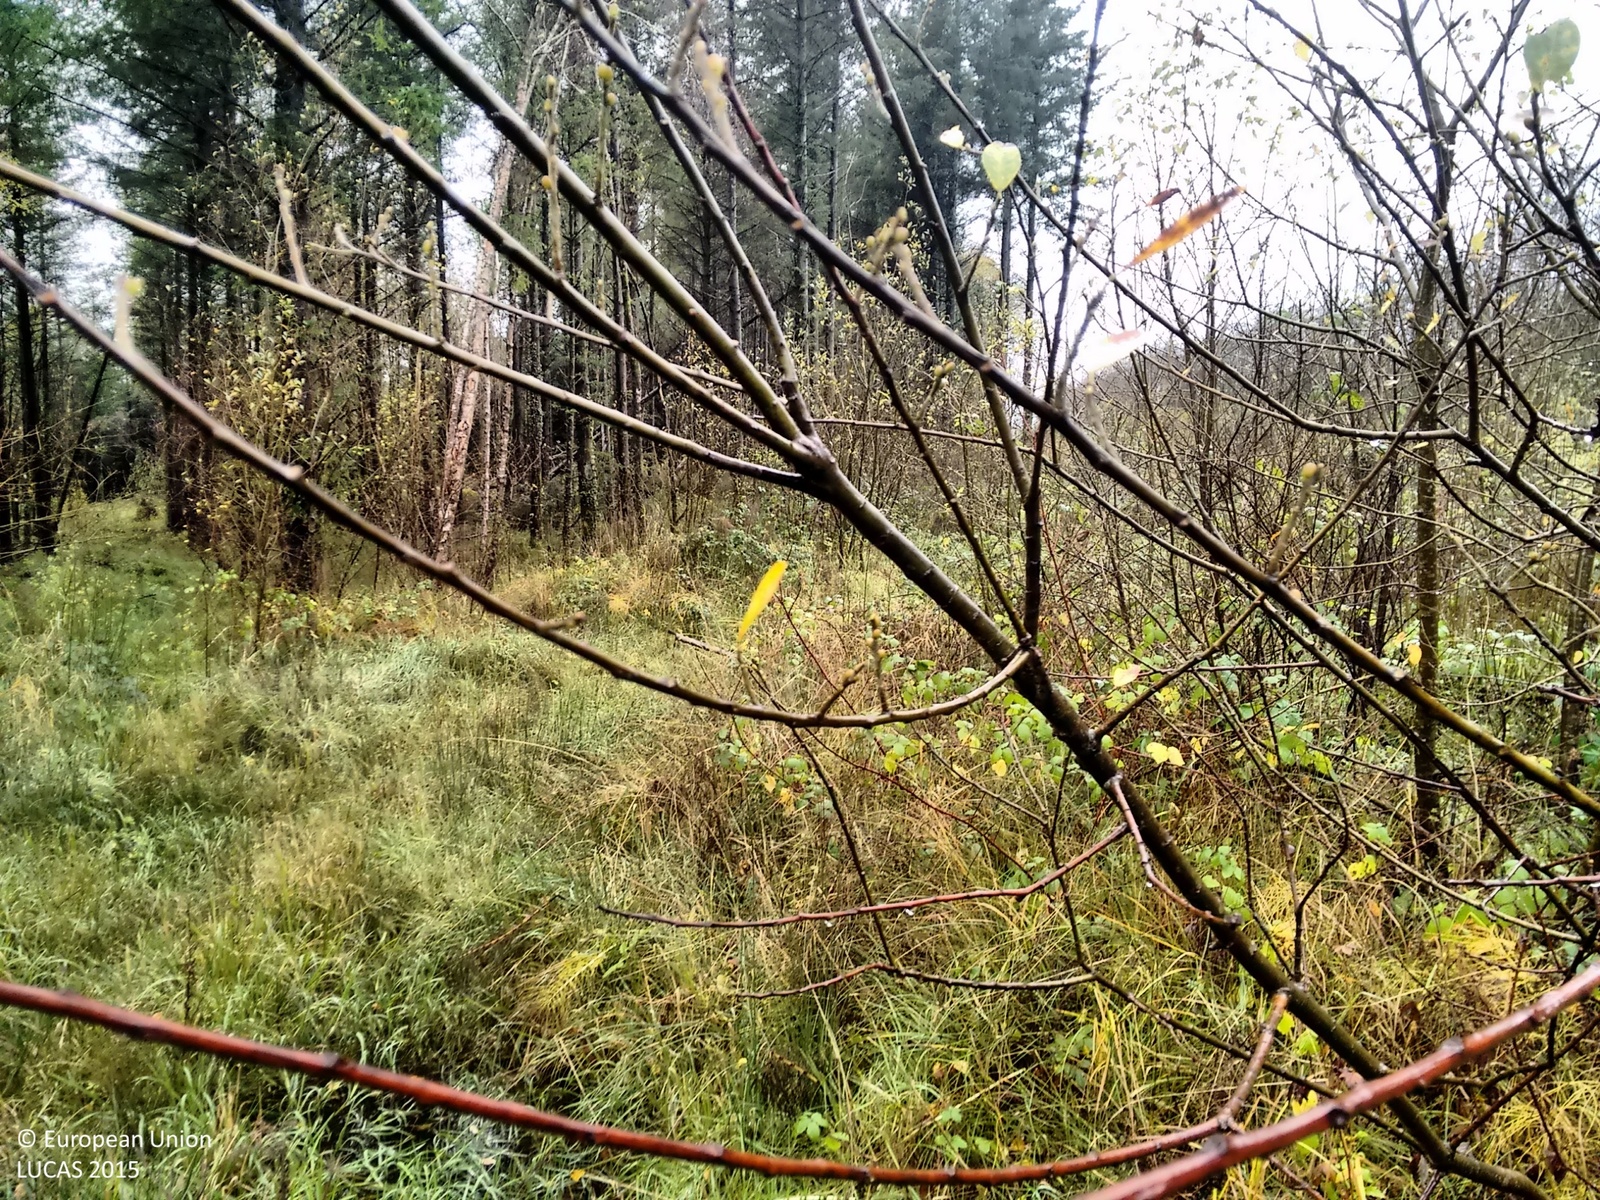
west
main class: Woodland
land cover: Pine dominated mixed woodland
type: exotic forest
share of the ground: > 75 %
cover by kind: coniferous forest trees 70 %, broadleaved forest trees 25 %, herbaceous plants 5 %
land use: Forestry
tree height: > 5 m
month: November
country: IE
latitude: 53.9357
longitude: -8.0116
